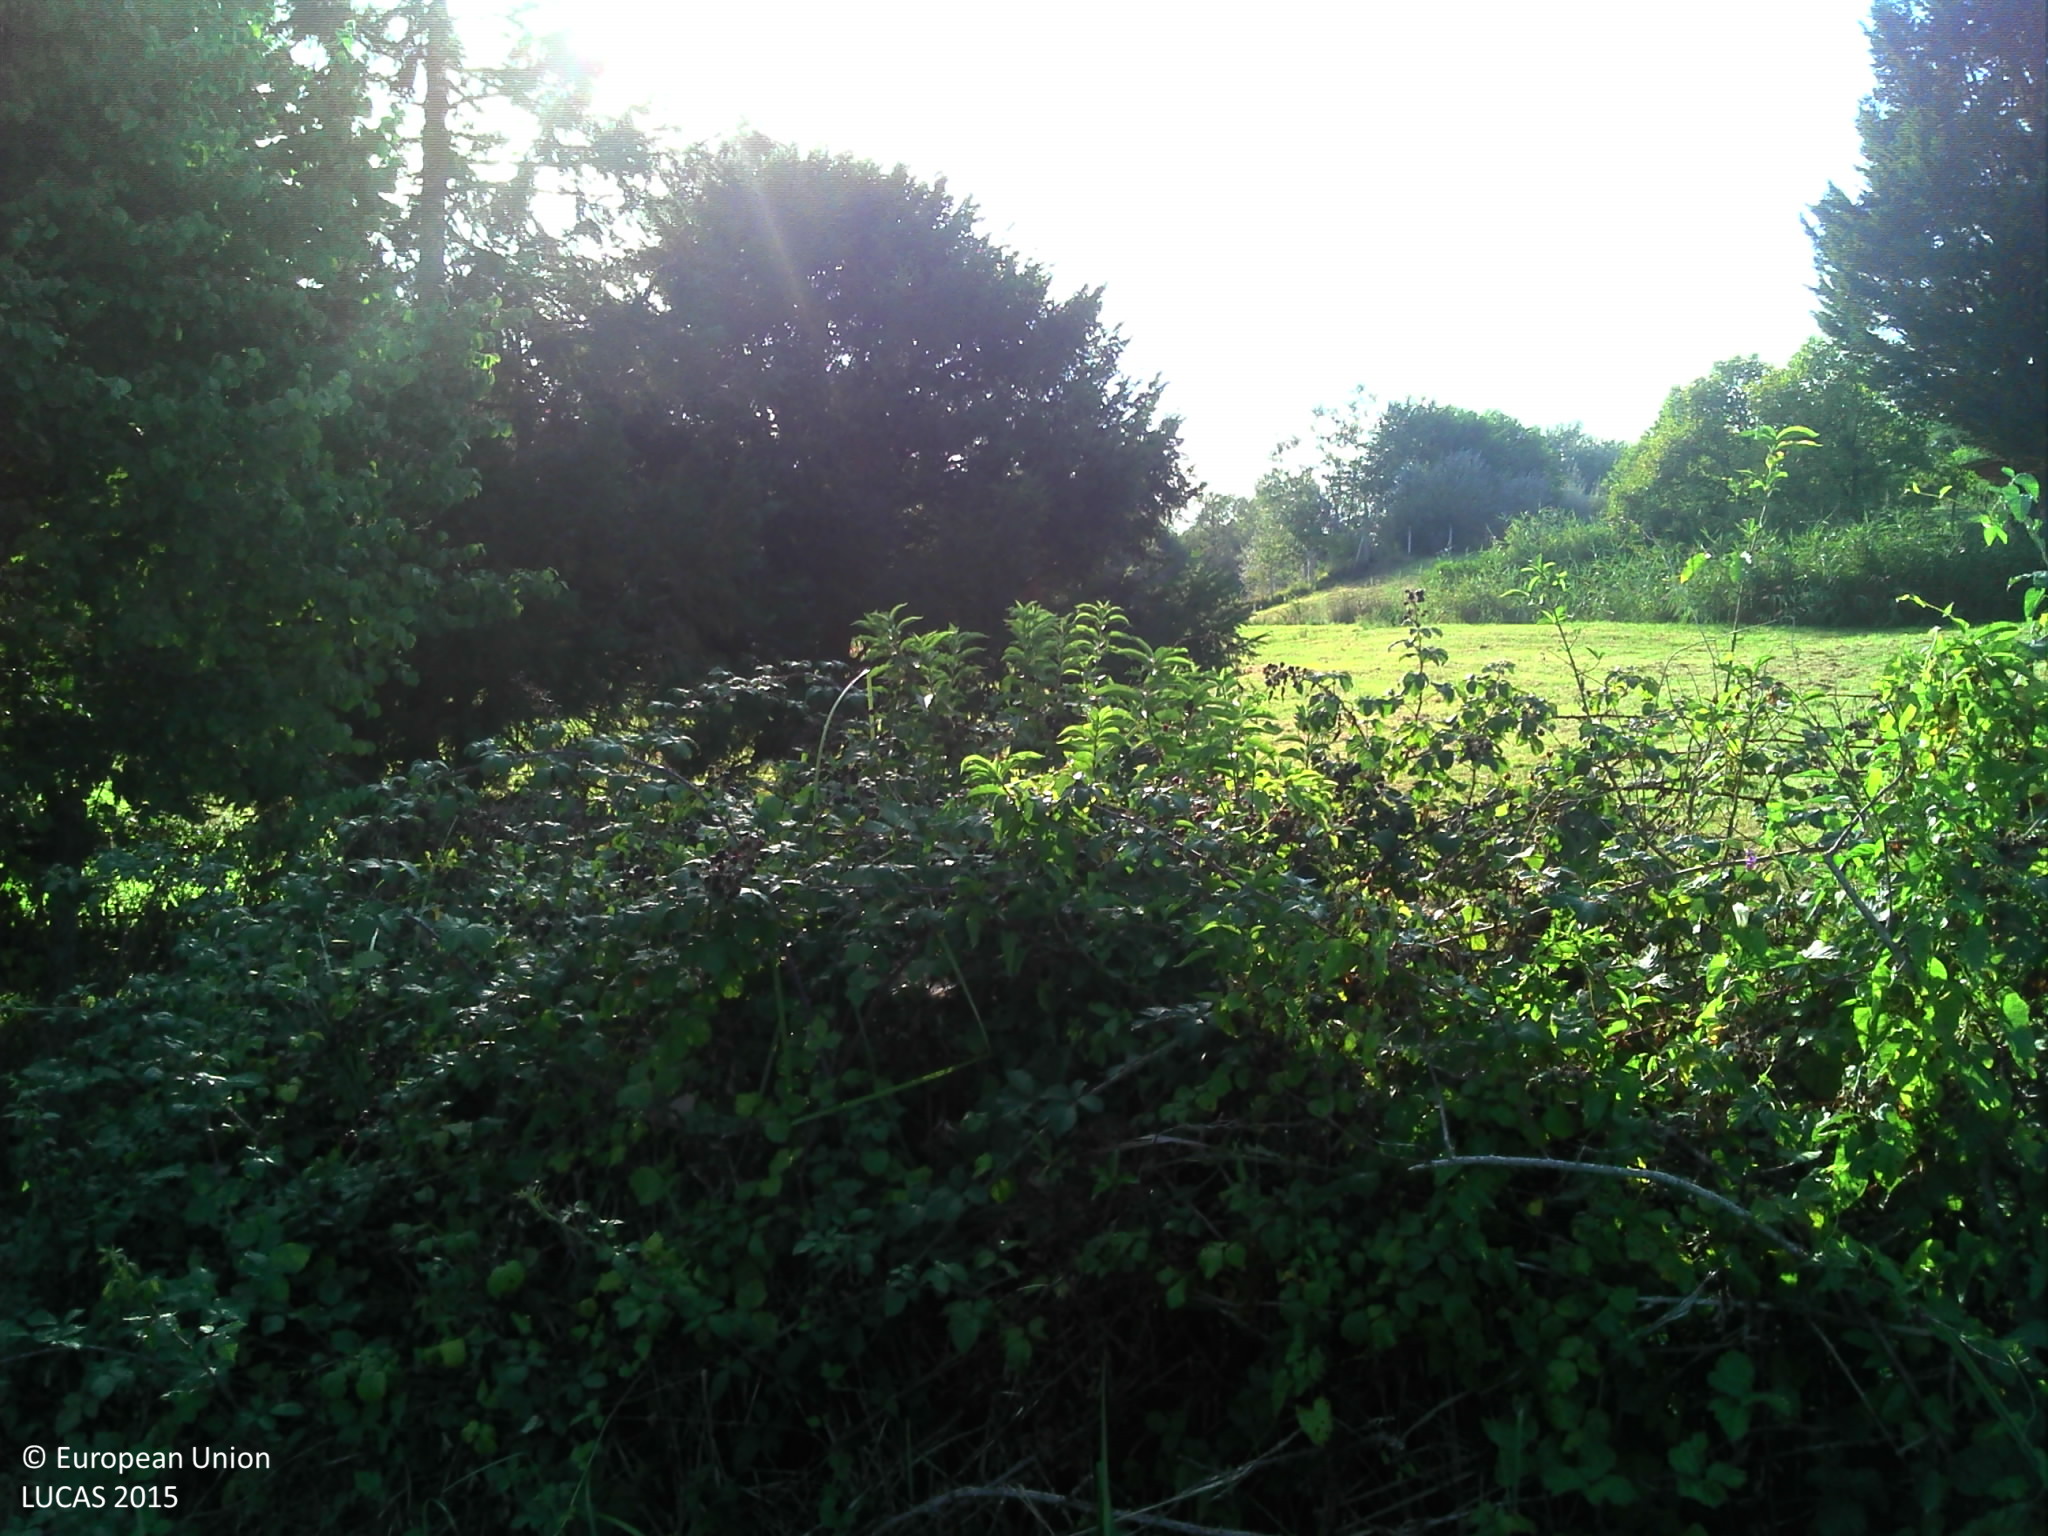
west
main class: Grassland
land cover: Grassland without tree/shrub cover
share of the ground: > 75 %
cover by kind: herbaceous plants 75 %, lichens and mosses 20 %, unconsolidated bare surface 5 %
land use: Residential
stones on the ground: < 10 %
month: August
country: FR
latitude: 45.4525
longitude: 0.4607
